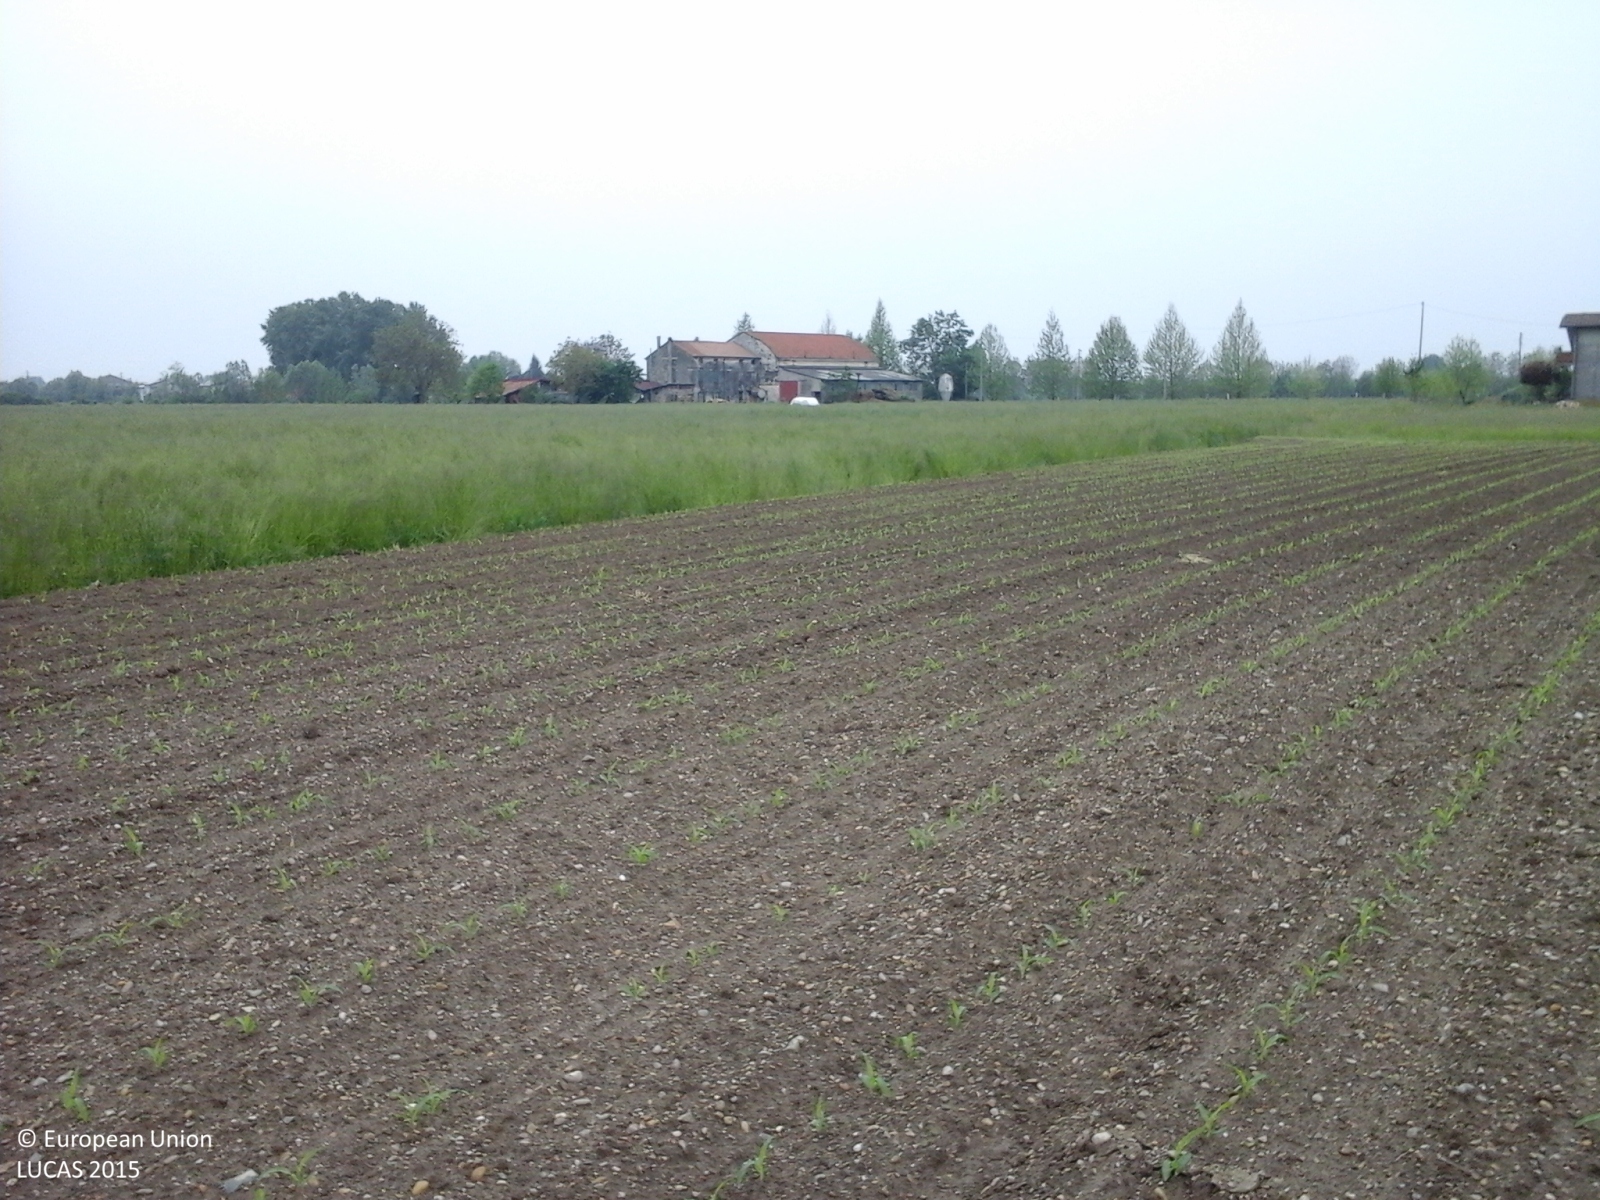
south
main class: Cropland
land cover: Maize
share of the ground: < 10 %
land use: Agriculture (excluding fallow land and kitchen gardens)
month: May
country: IT
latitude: 45.5083
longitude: 11.7251
